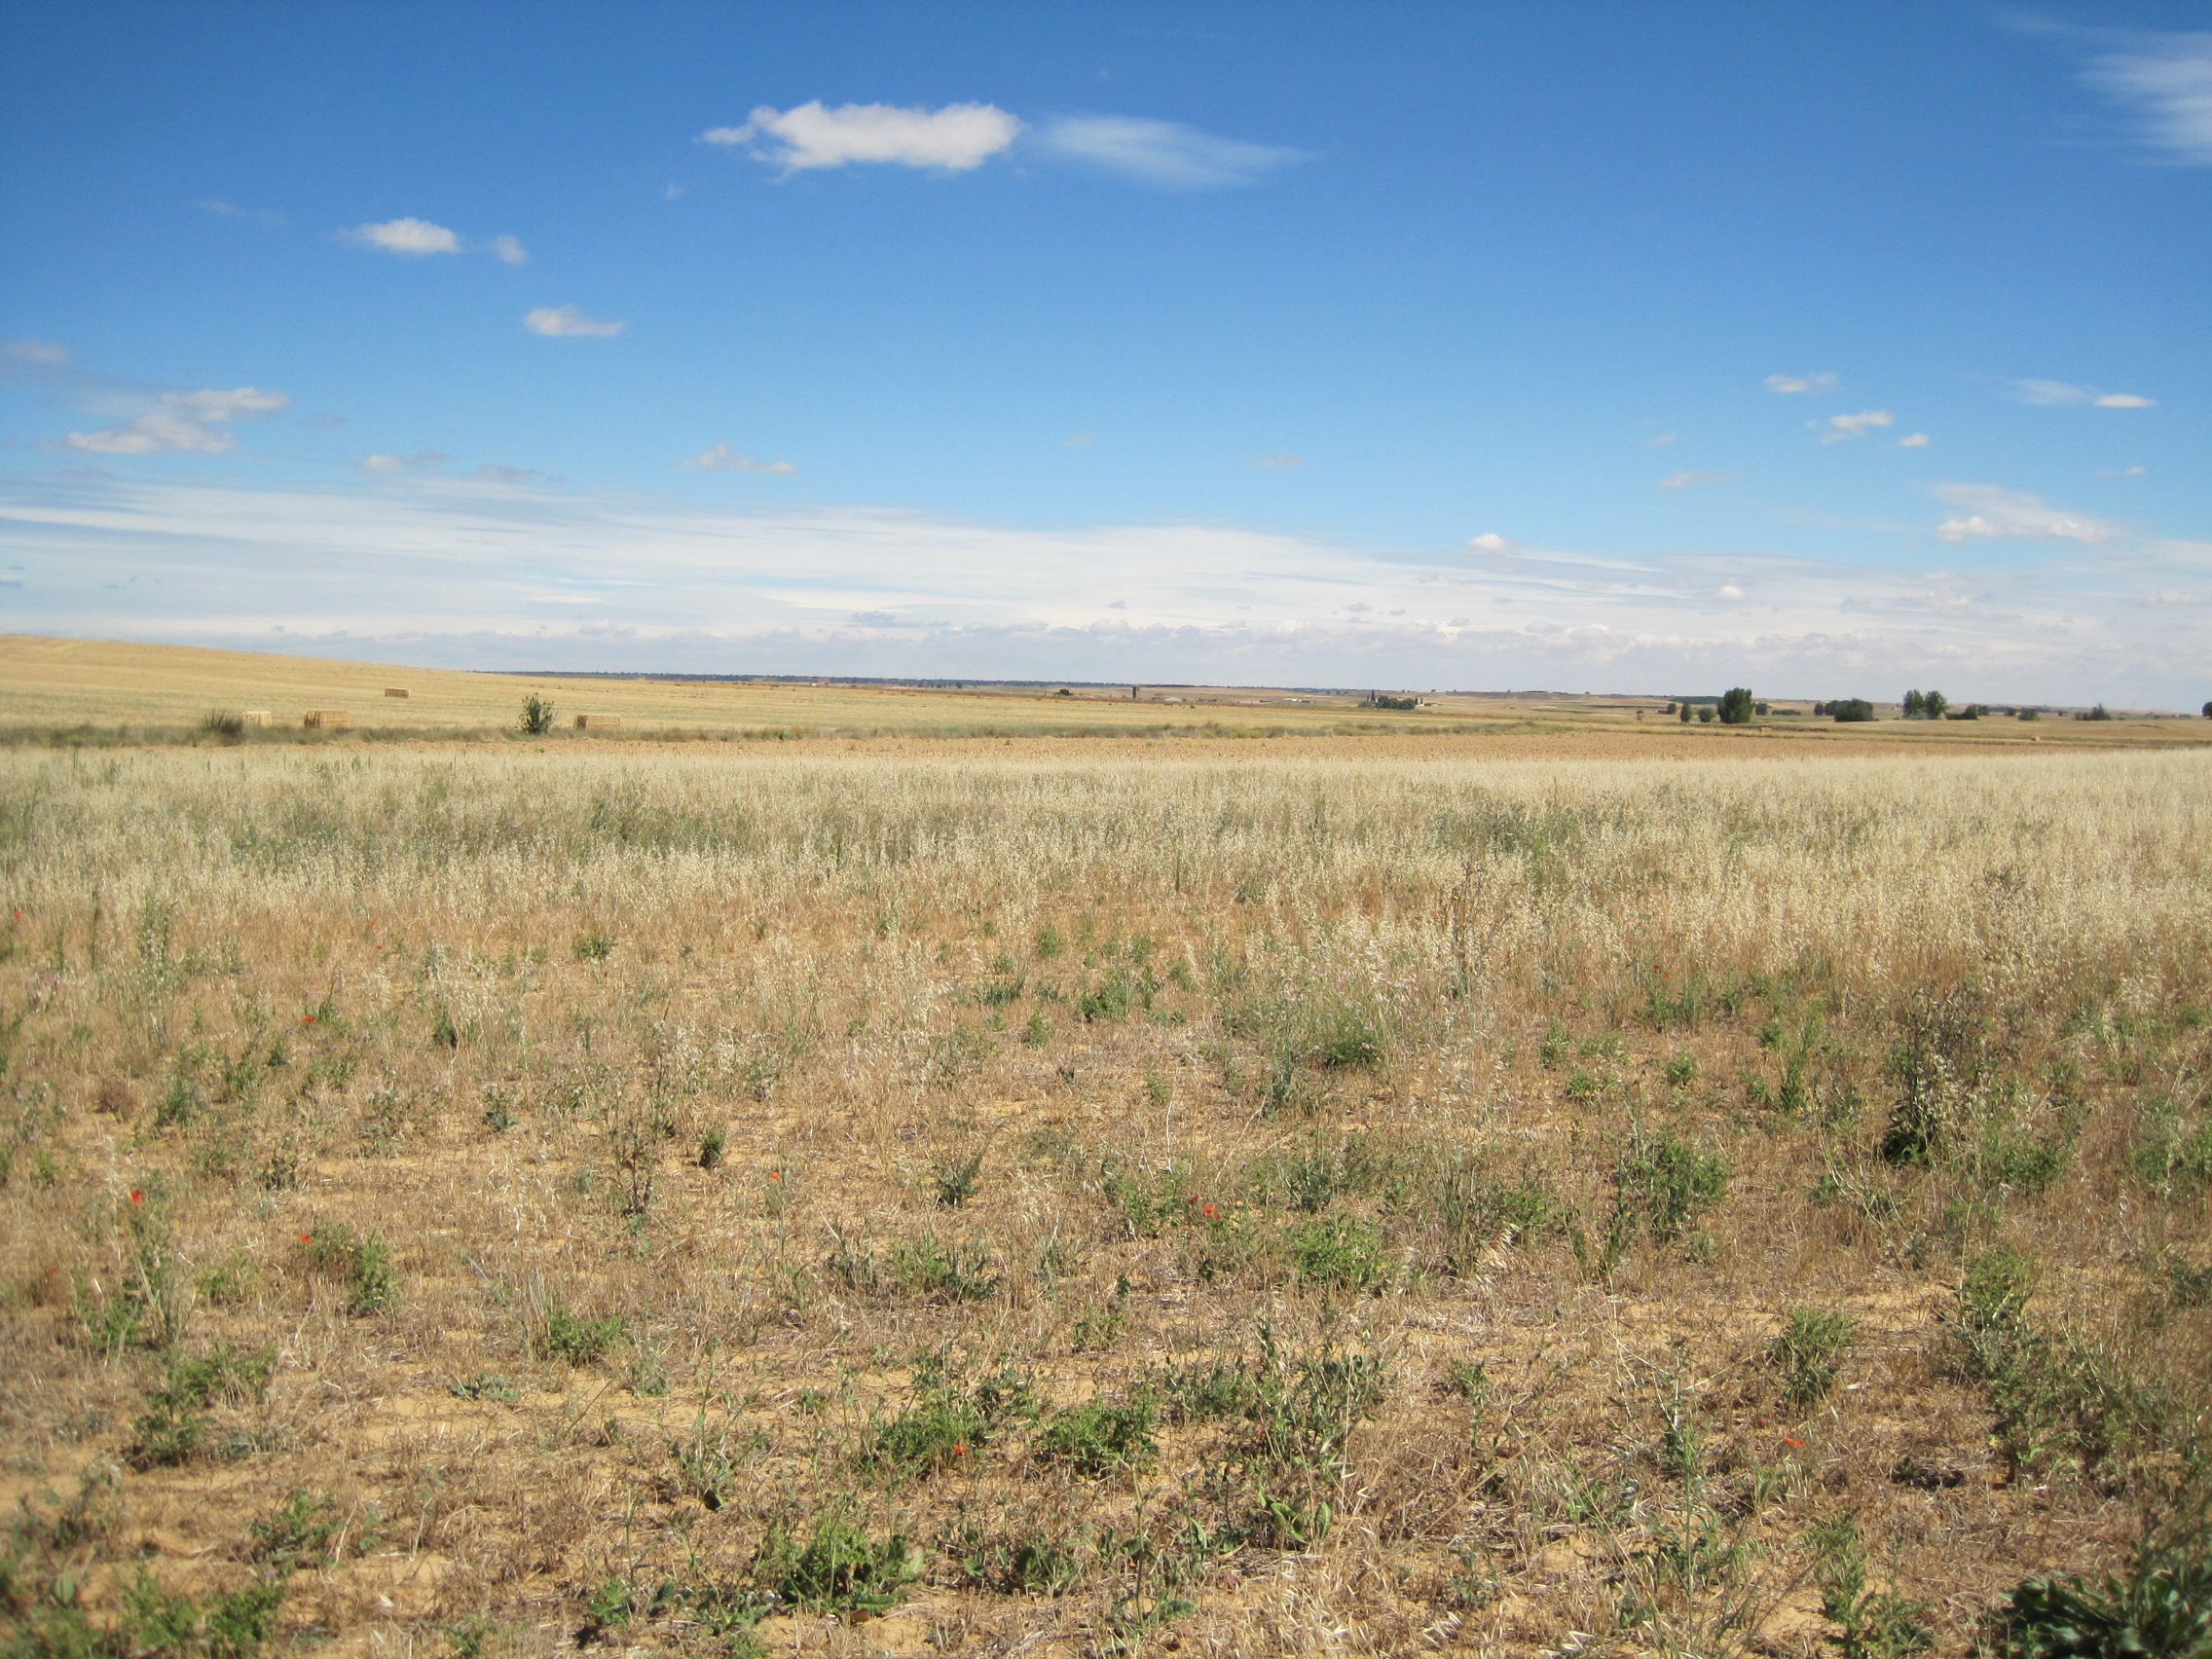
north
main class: Grassland
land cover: Spontaneously vegetated surfaces
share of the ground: > 75 %
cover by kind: herbaceous plants 90 %, unconsolidated bare surface 10 %
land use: Agriculture (excluding fallow land and kitchen gardens)
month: July
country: ES
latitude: 41.9772
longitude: -5.5485
